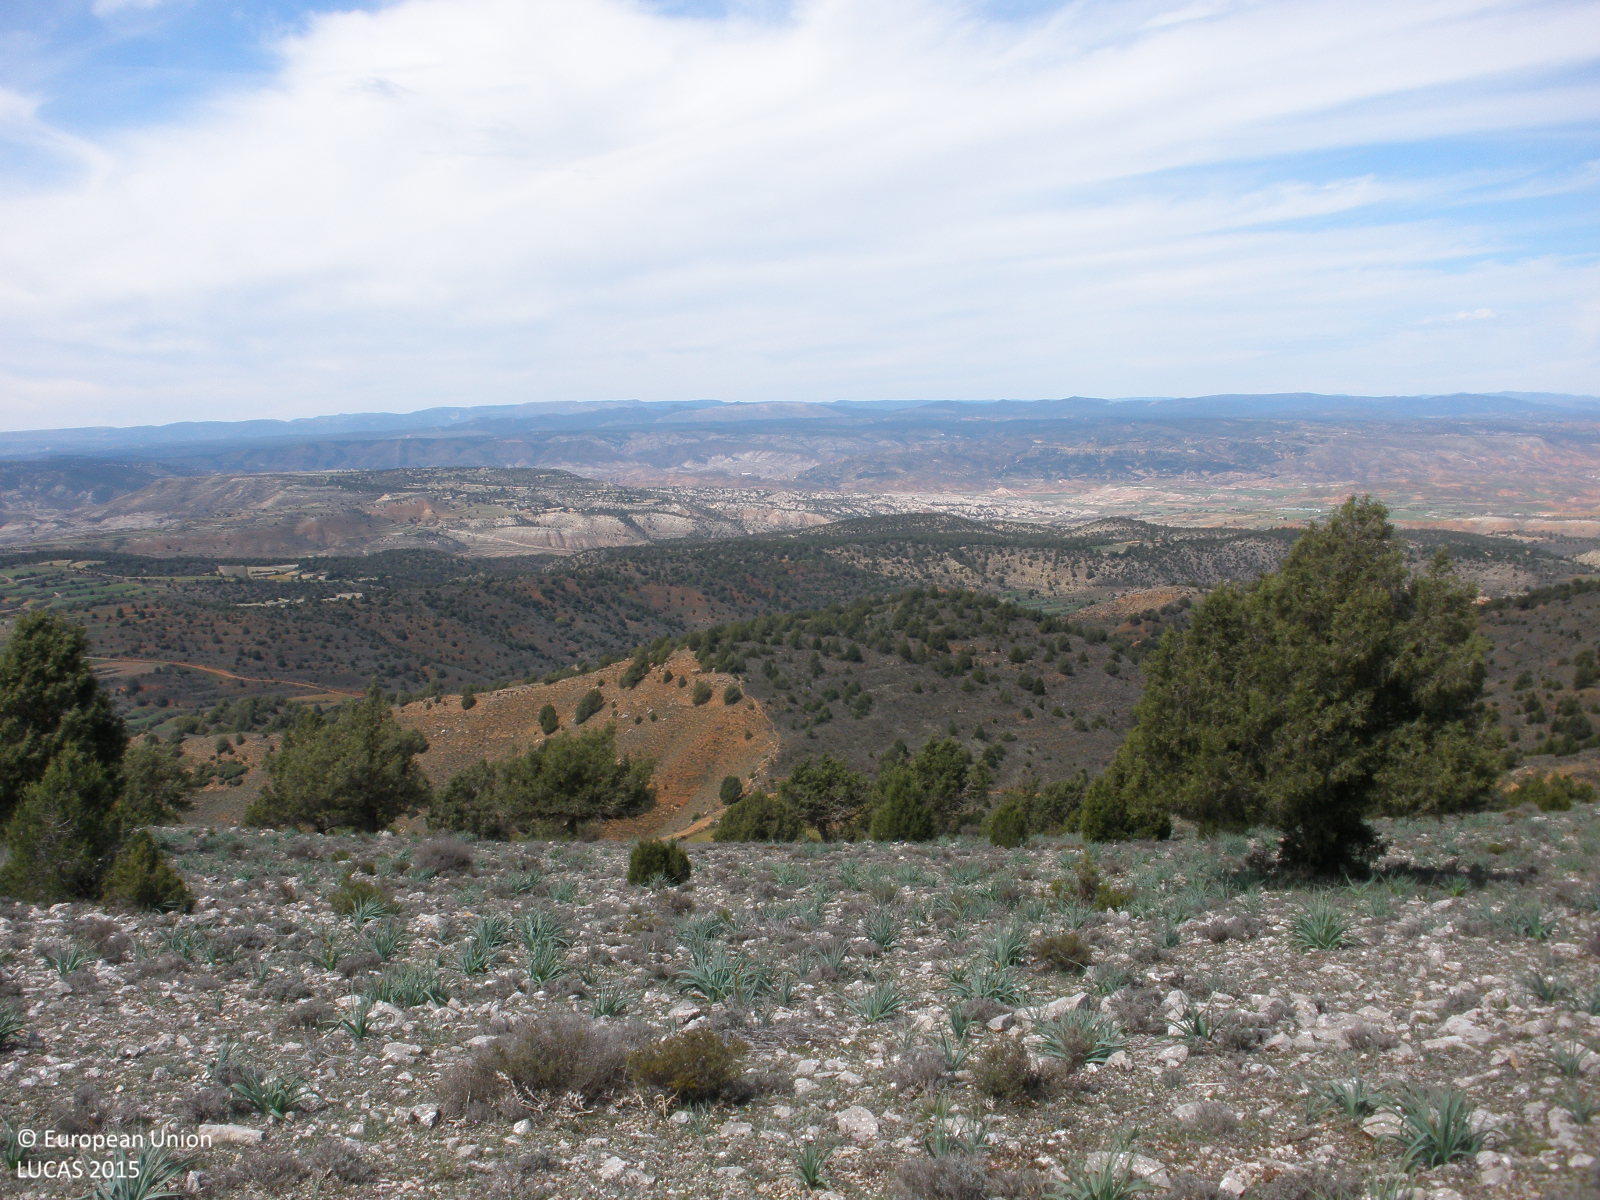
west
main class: Woodland
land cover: Other coniferous woodland
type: coniferous forest of the mediterranean region
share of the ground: 10 - 25 %
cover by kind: consolidated bare surface 45 %, shrubs 20 %, herbaceous plants 20 %, coniferous forest trees 15 %
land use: Semi-natural and natural areas not in use
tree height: < 5 m
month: April
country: ES
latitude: 40.2256
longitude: -1.0441
